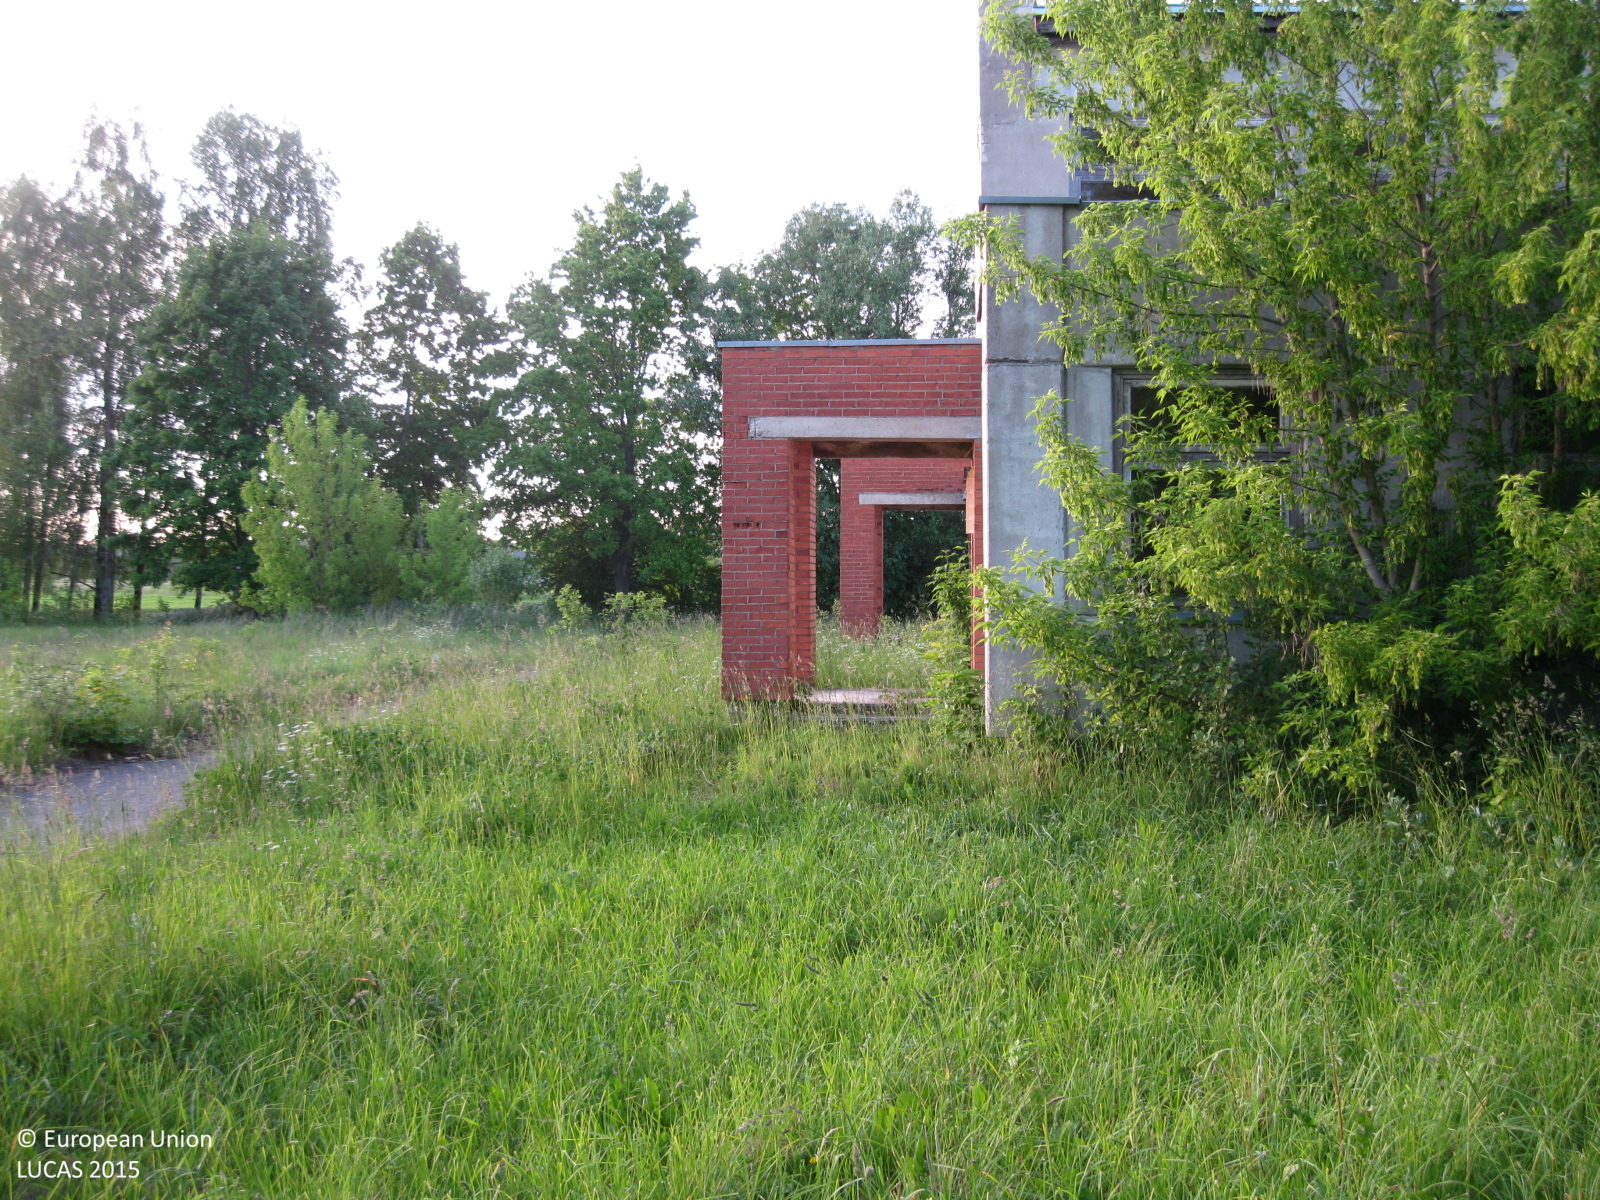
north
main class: Grassland
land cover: Grassland with sparse tree/shrub cover
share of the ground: > 75 %
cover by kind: herbaceous plants 90 %, coniferous forest trees 5 %, shrubs 5 %
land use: Abandoned areas
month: June
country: LT
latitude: 55.4521
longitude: 23.6645
